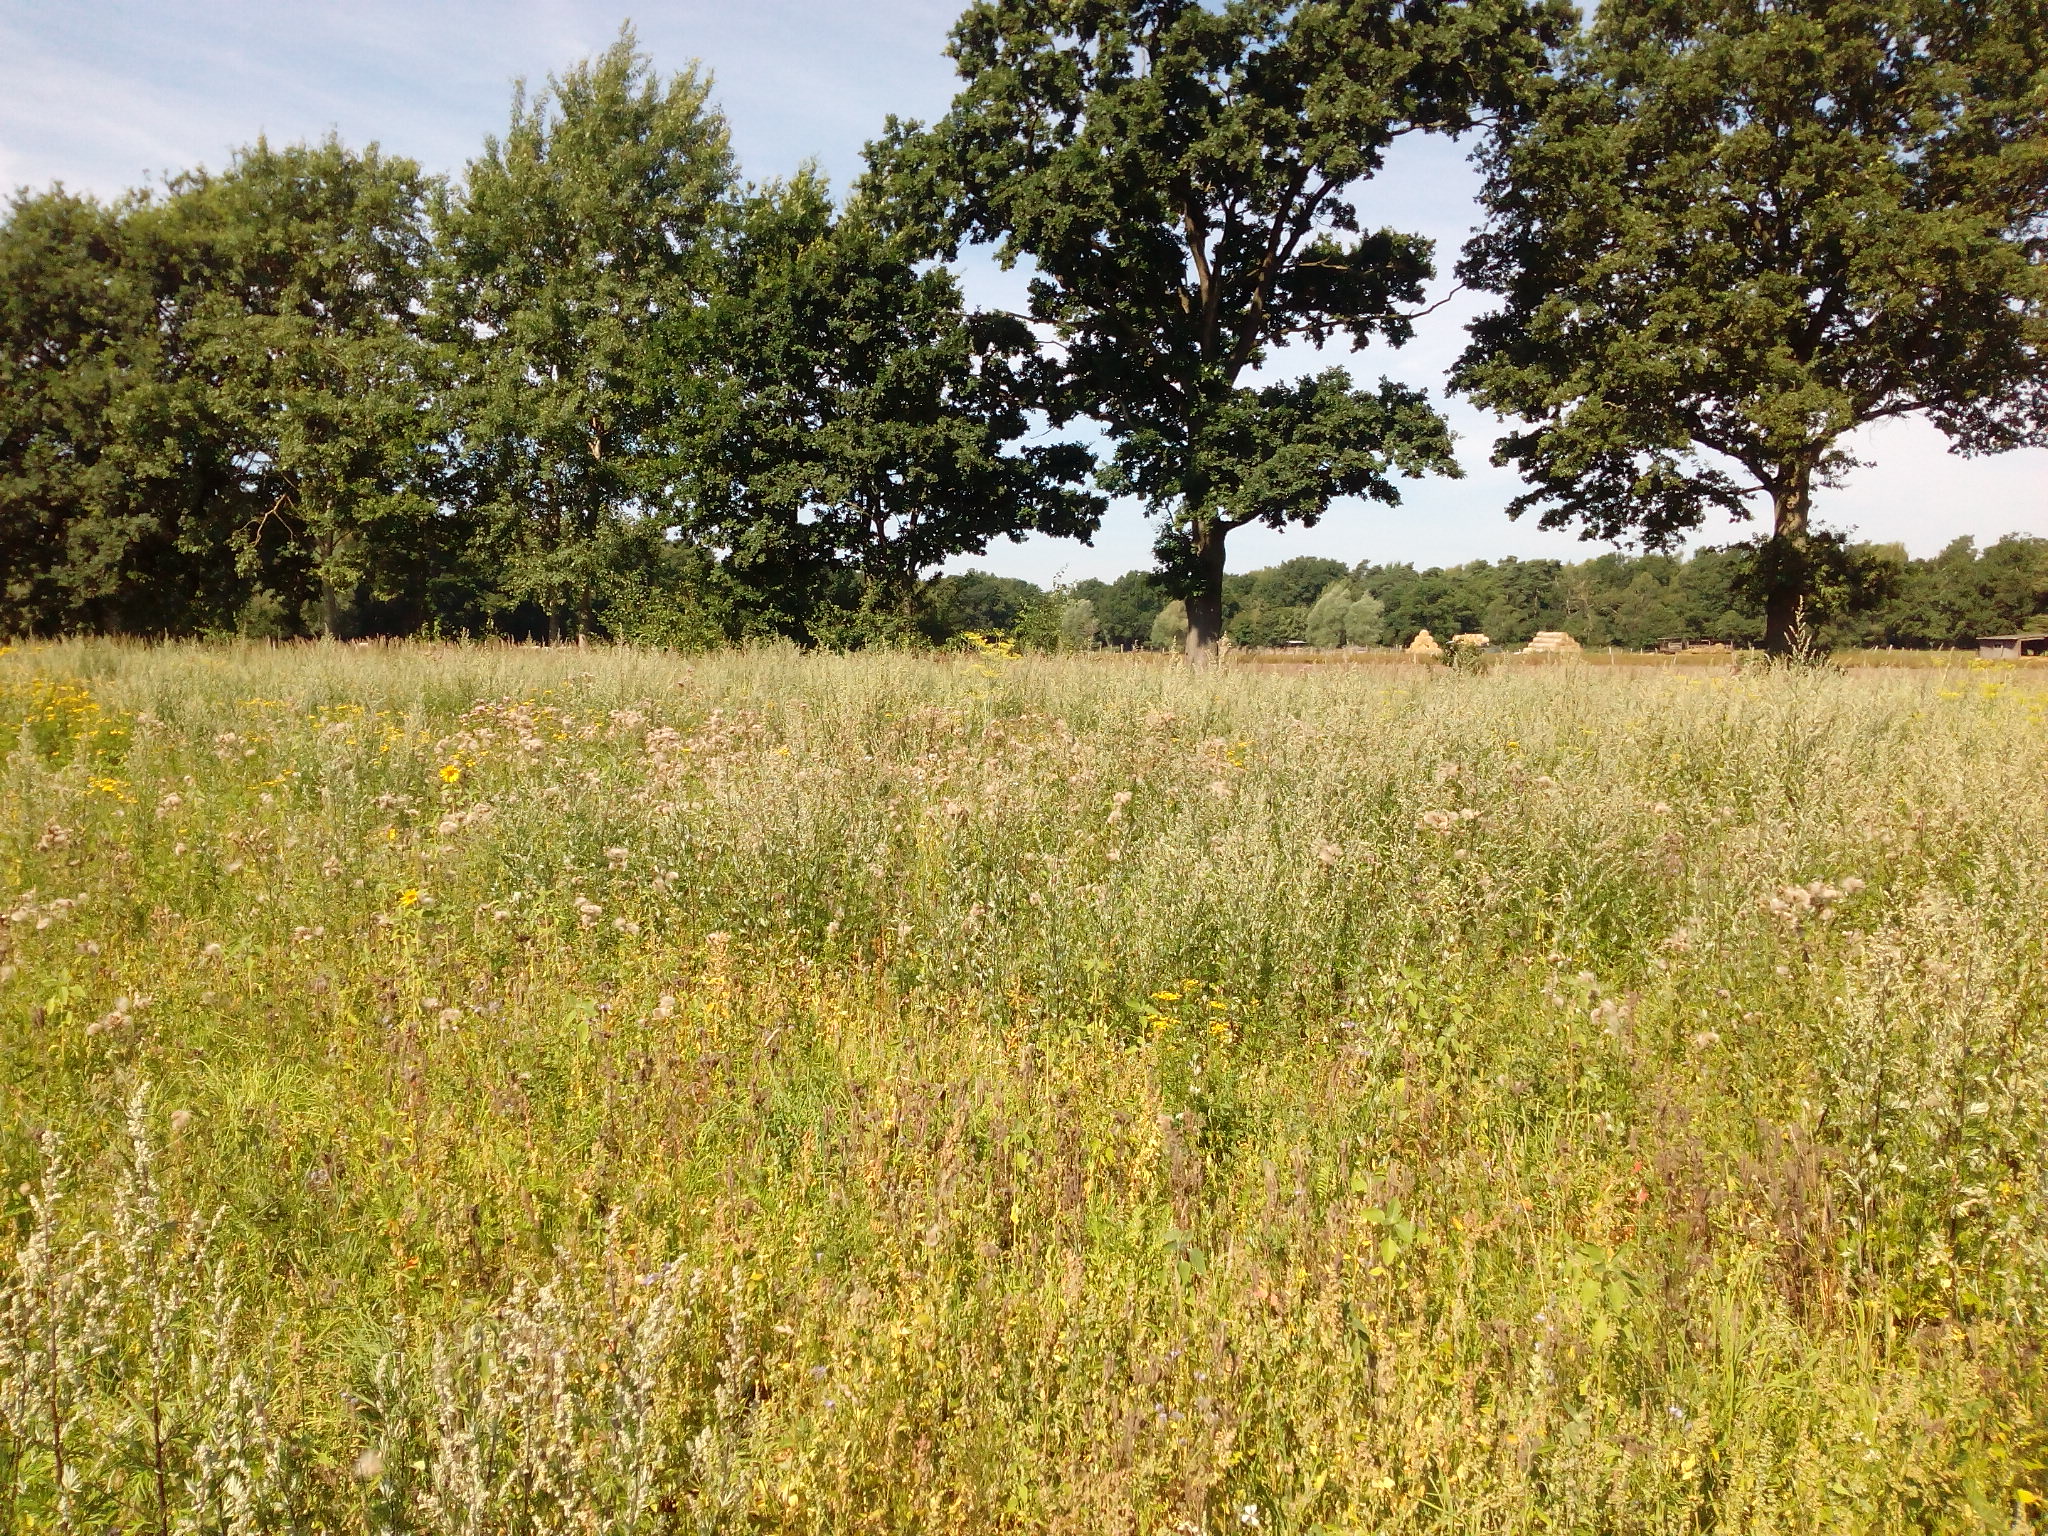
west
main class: Grassland
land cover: Grassland without tree/shrub cover
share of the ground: > 75 %
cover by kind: herbaceous plants 100 %
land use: Agriculture (excluding fallow land and kitchen gardens)
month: August
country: DE
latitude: 52.4853
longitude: 9.9264
